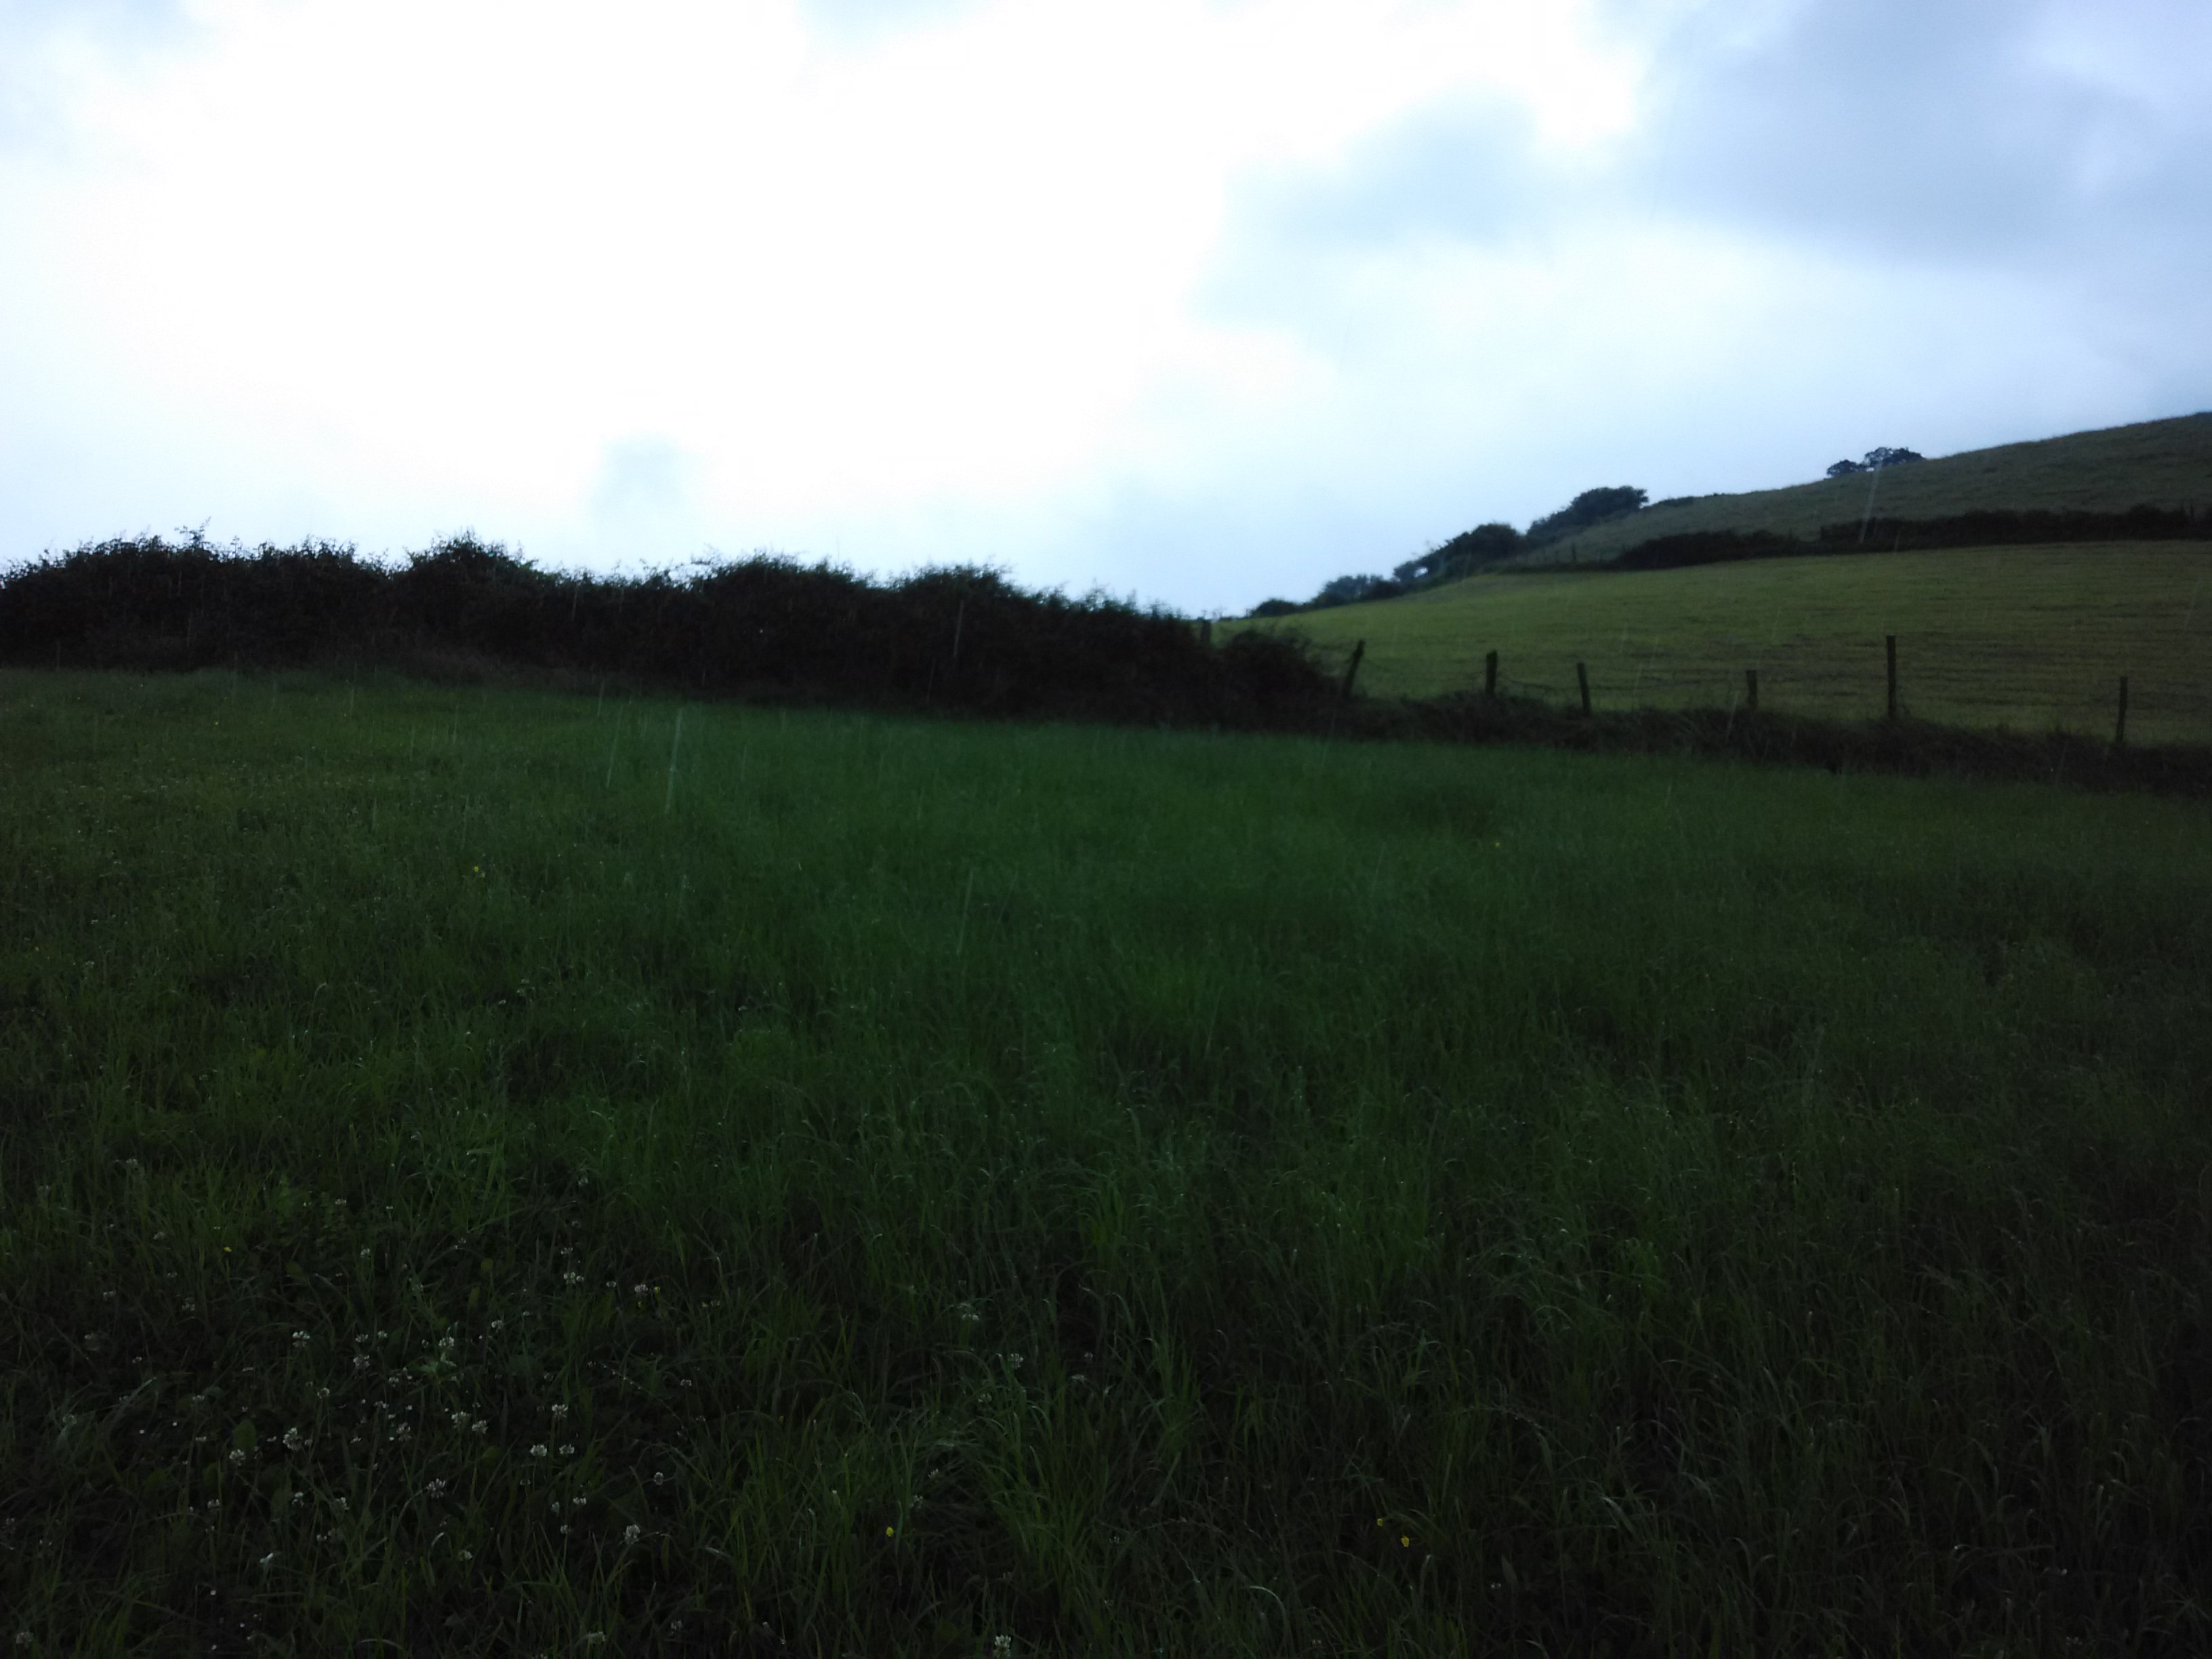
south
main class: Grassland
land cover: Grassland without tree/shrub cover
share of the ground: > 75 %
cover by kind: herbaceous plants 100 %
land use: Agriculture (excluding fallow land and kitchen gardens)
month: June
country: ES
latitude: 43.2889
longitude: -2.2889
